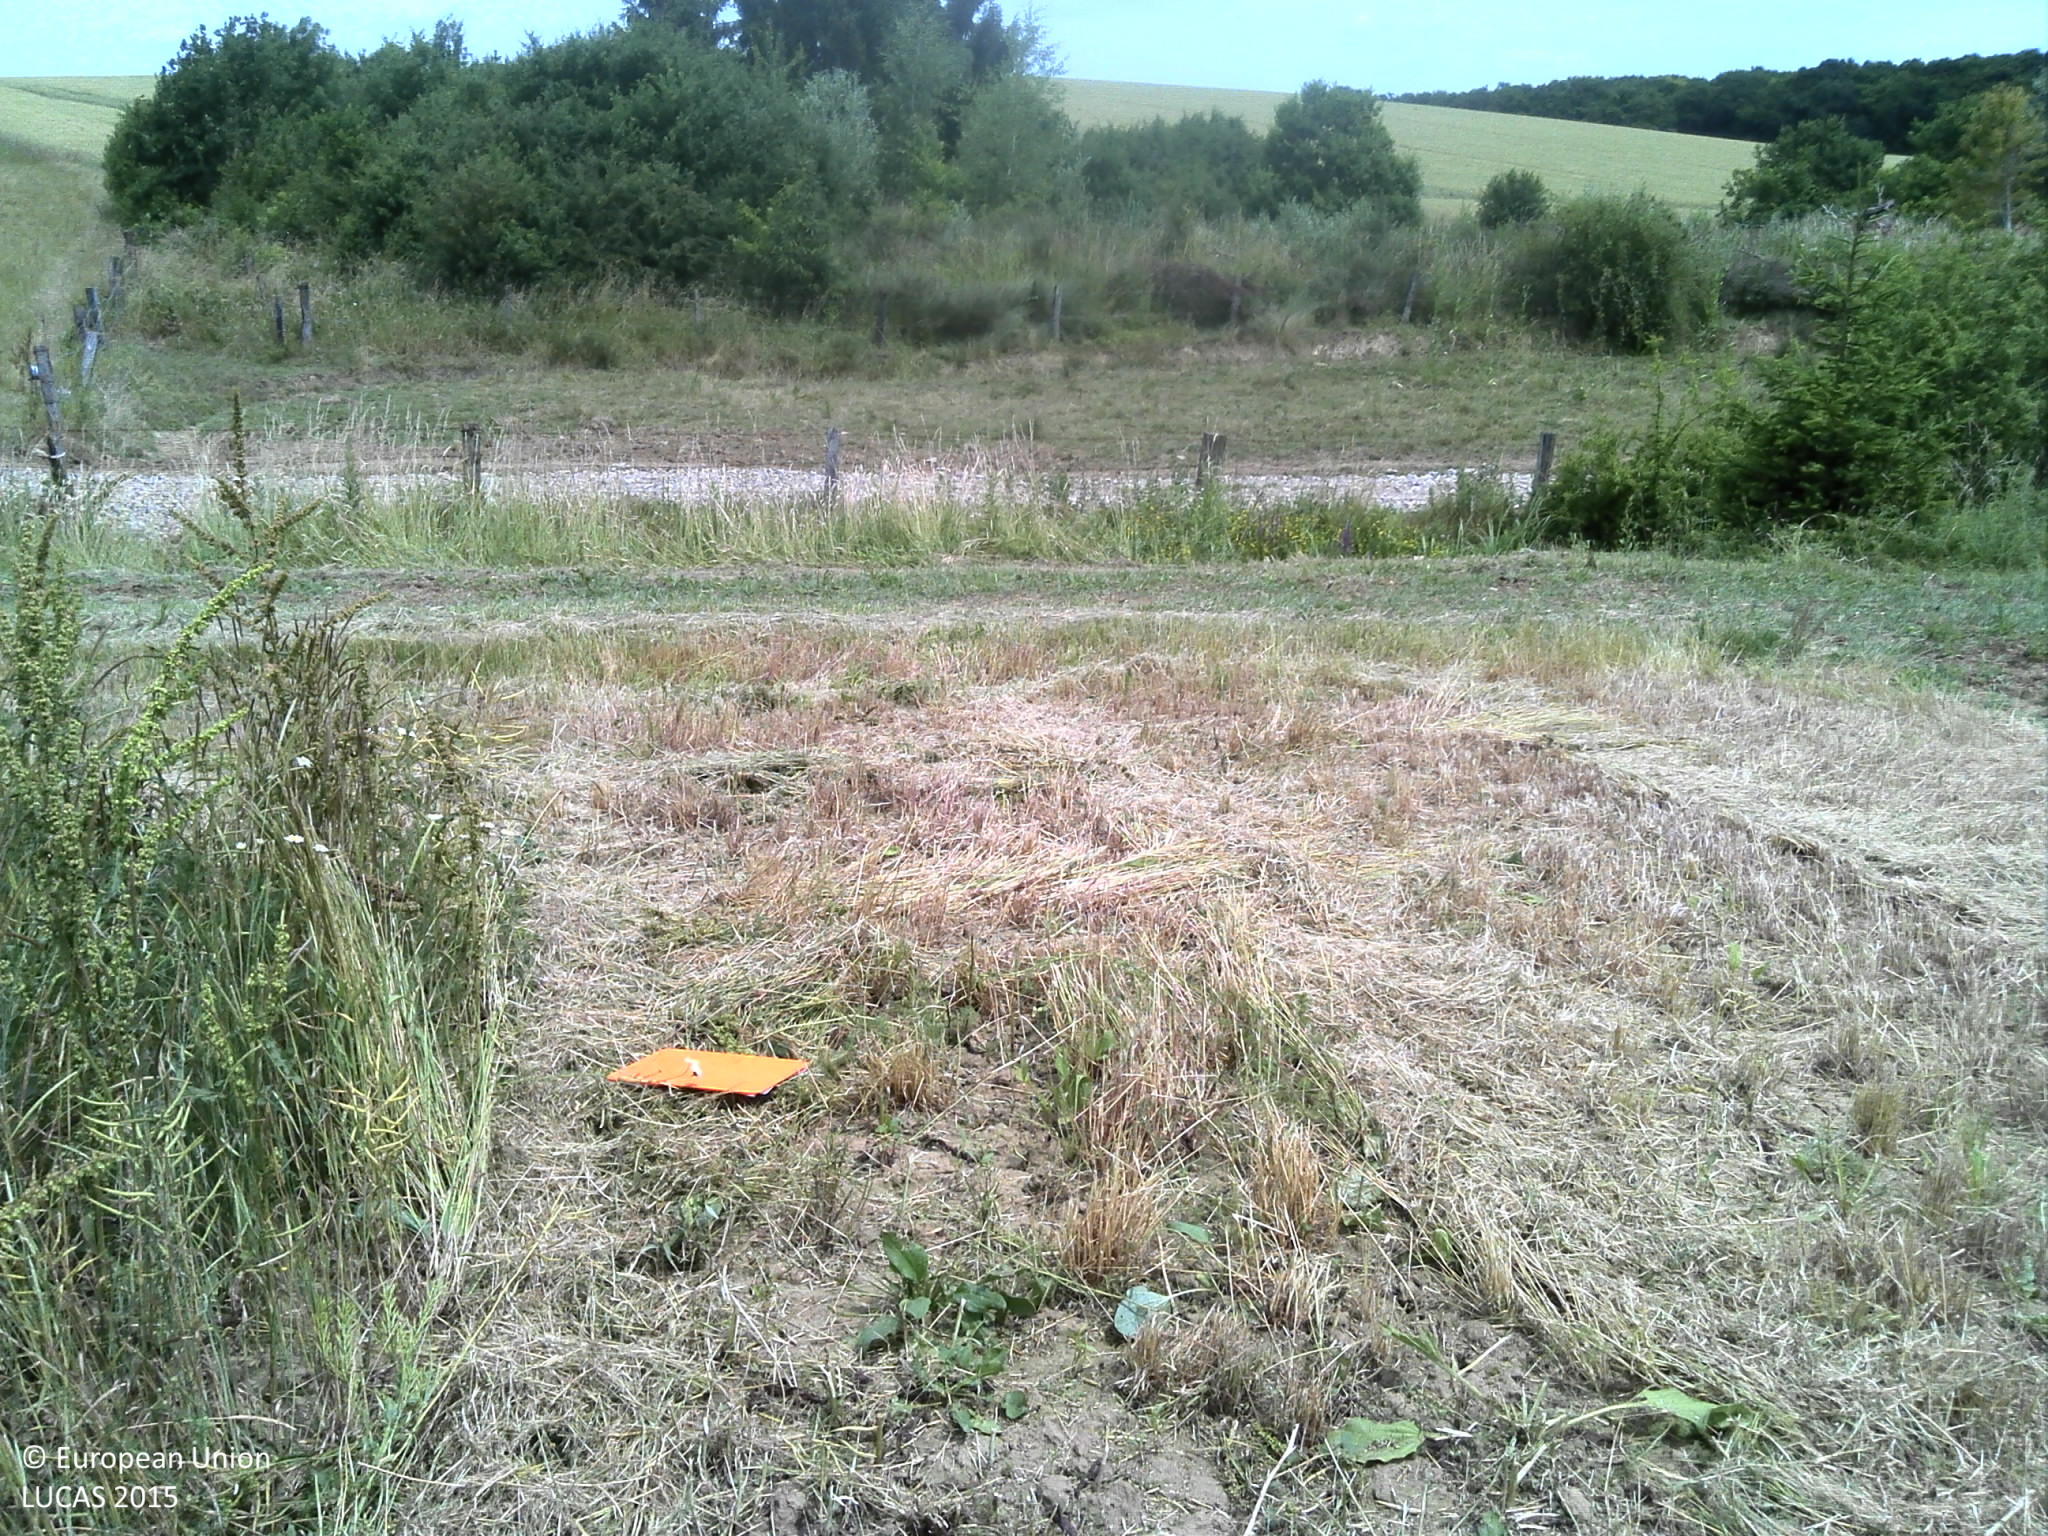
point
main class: Grassland
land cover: Grassland without tree/shrub cover
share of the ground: > 75 %
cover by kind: herbaceous plants 100 %
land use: Agriculture (excluding fallow land and kitchen gardens)
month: June
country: FR
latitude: 49.2943
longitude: 6.2459
